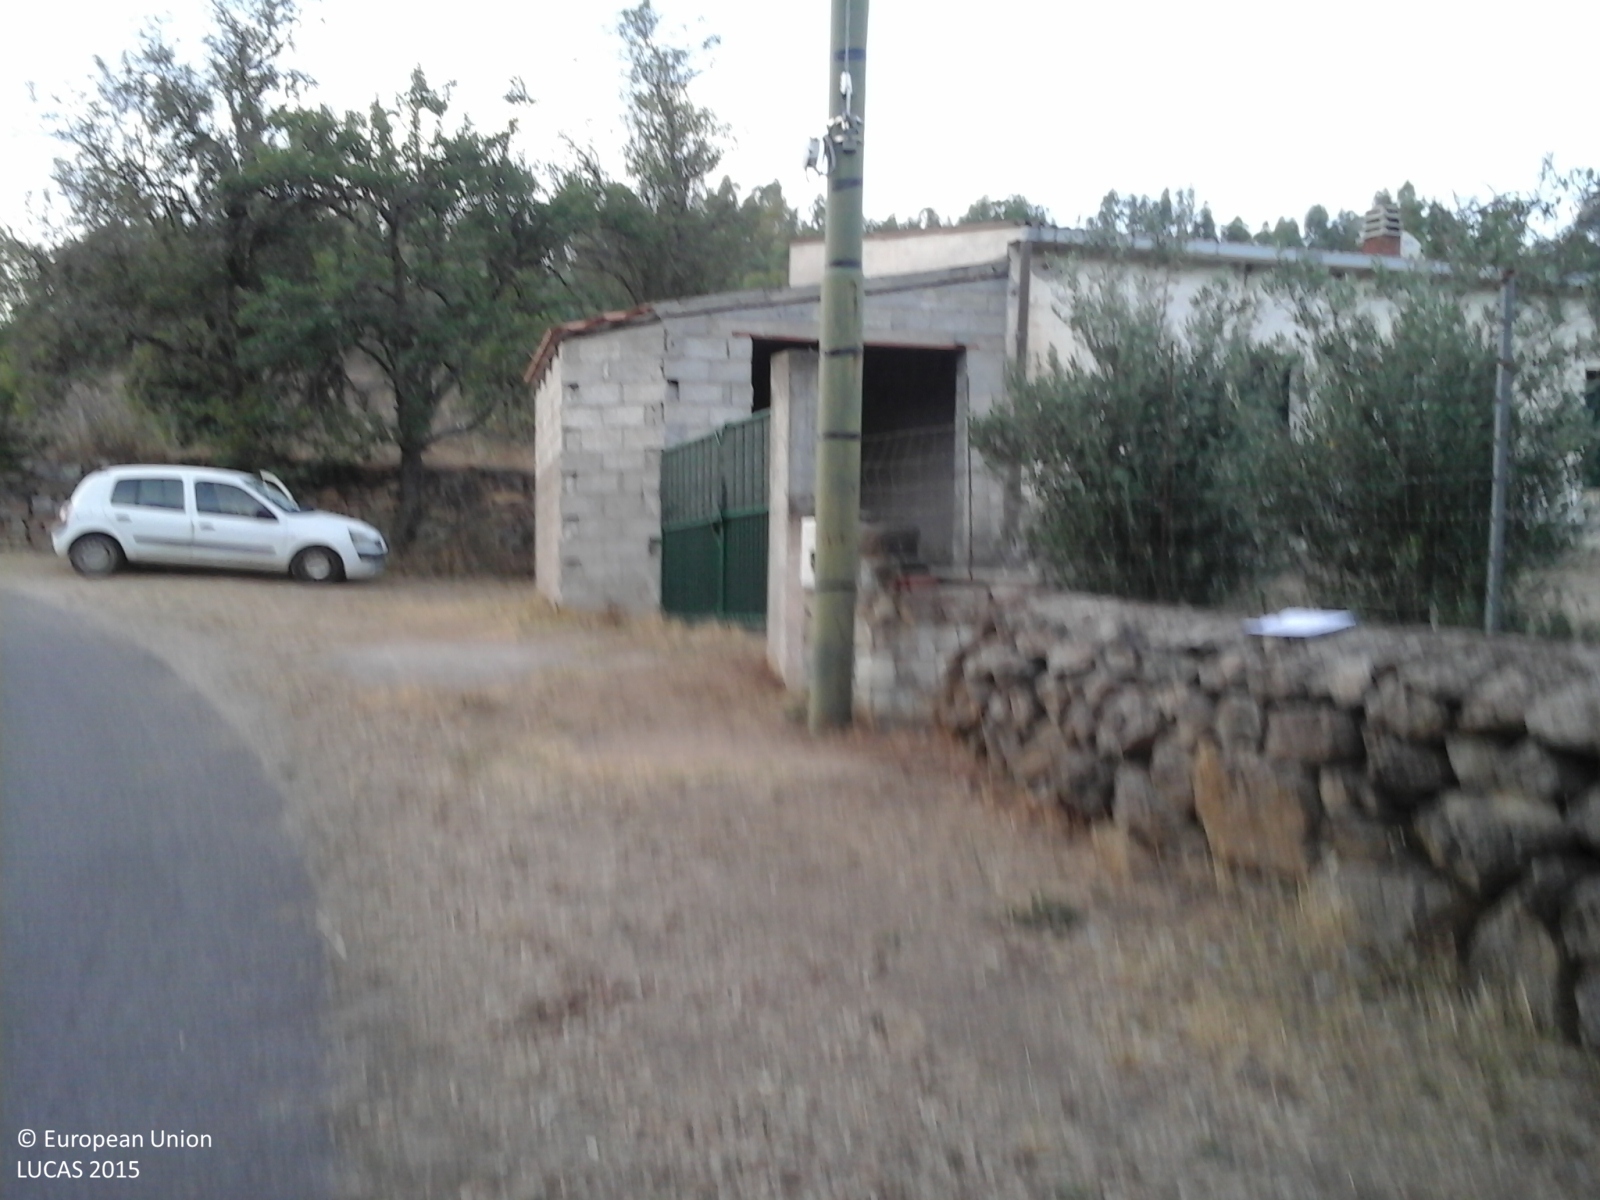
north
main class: Cropland
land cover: Vineyards
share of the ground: > 75 %
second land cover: Spontaneously vegetated surfaces
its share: 50 - 75 %
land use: Agriculture (excluding fallow land and kitchen gardens)
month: August
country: IT
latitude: 39.9724
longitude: 8.9869
